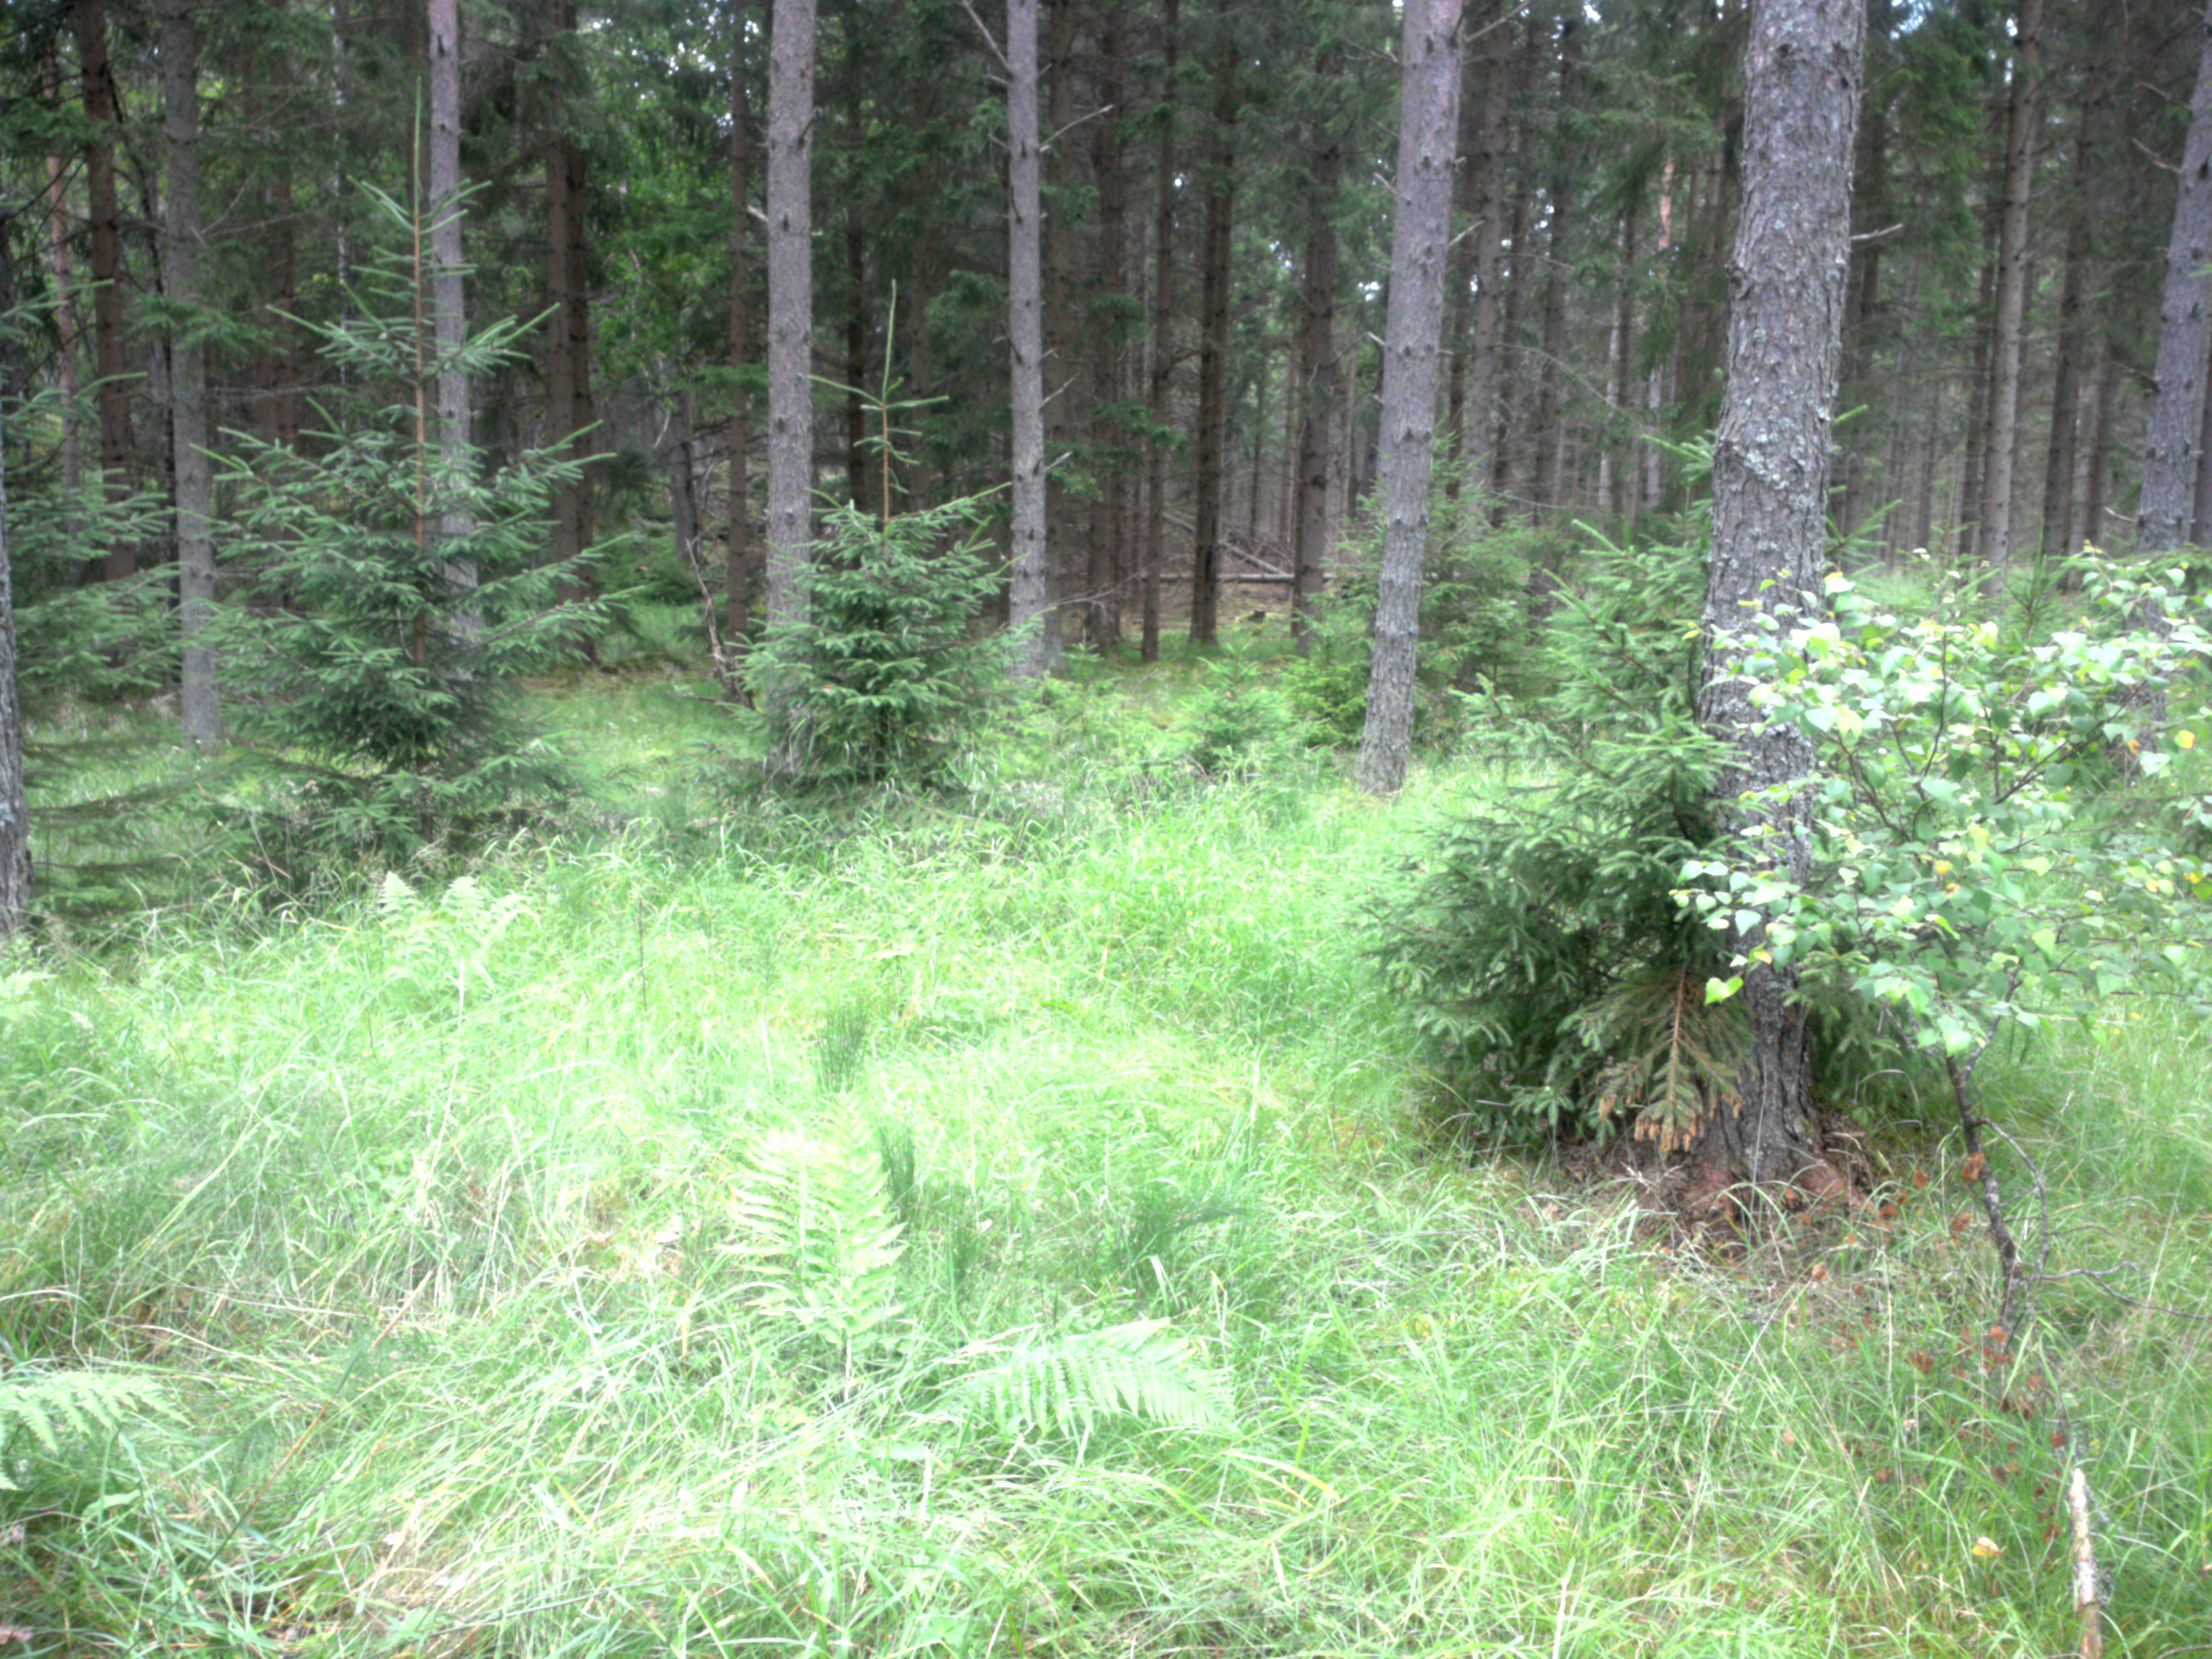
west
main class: Woodland
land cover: Pine dominated coniferous woodland
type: boreal forest
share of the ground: 50 - 75 %
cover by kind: coniferous forest trees 65 %, herbaceous plants 35 %
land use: Forestry
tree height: > 5 m
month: July
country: SE
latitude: 59.1452
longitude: 18.1988
